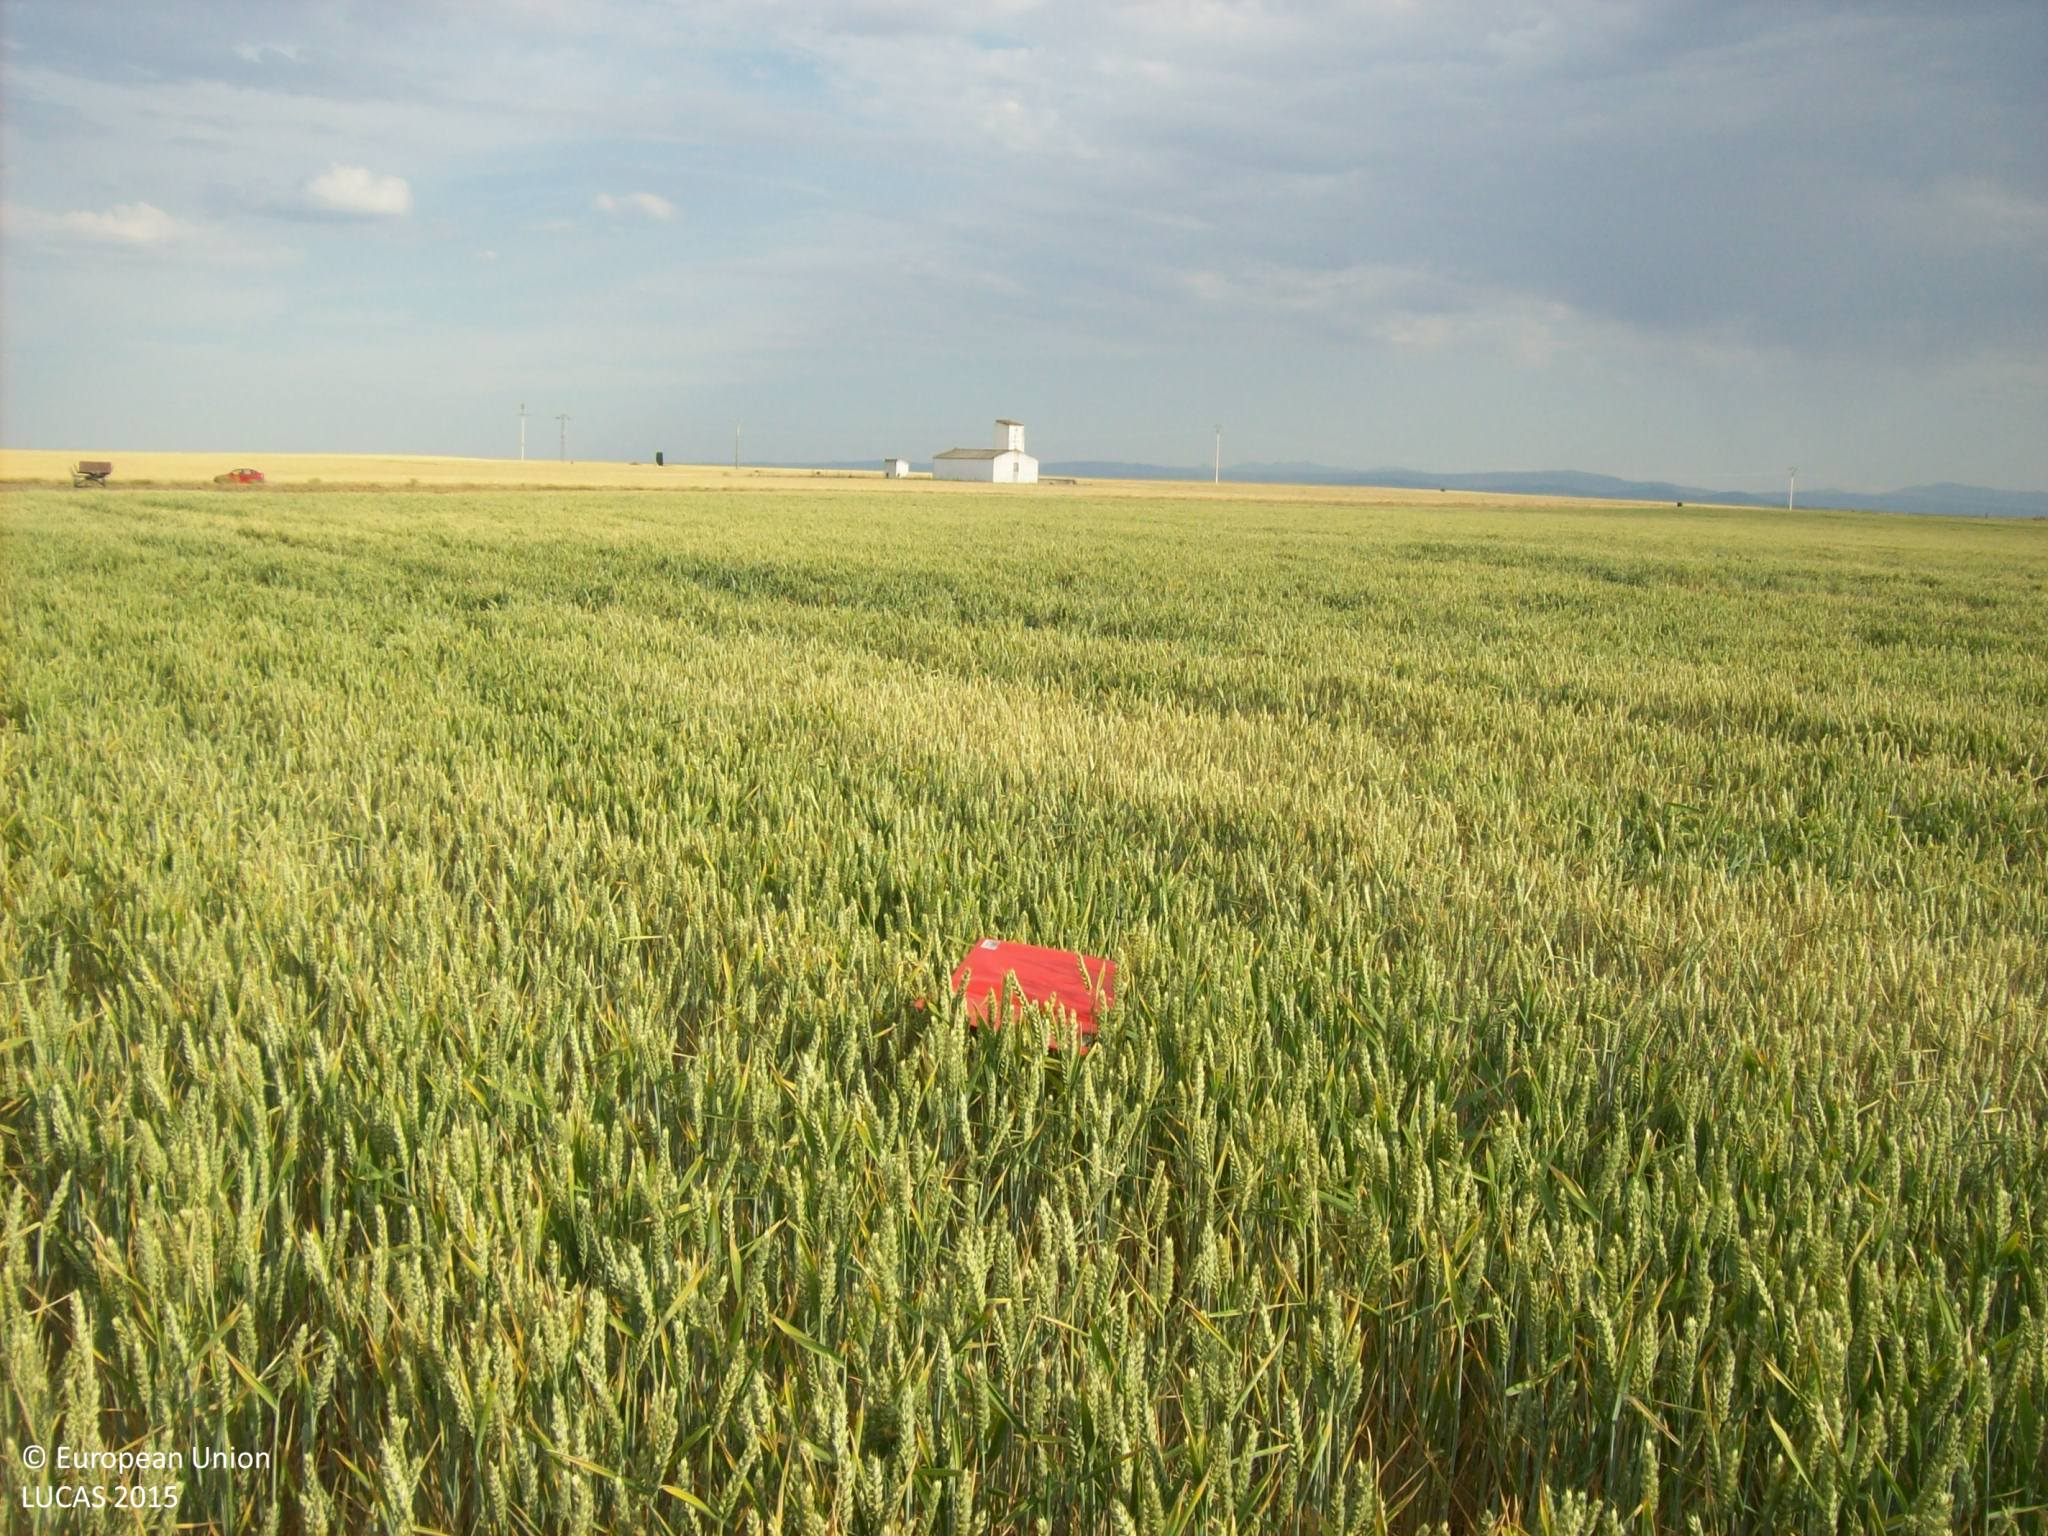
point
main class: Cropland
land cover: Common wheat
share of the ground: > 75 %
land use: Agriculture (excluding fallow land and kitchen gardens)
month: June
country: ES
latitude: 41.0459
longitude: -5.0448
